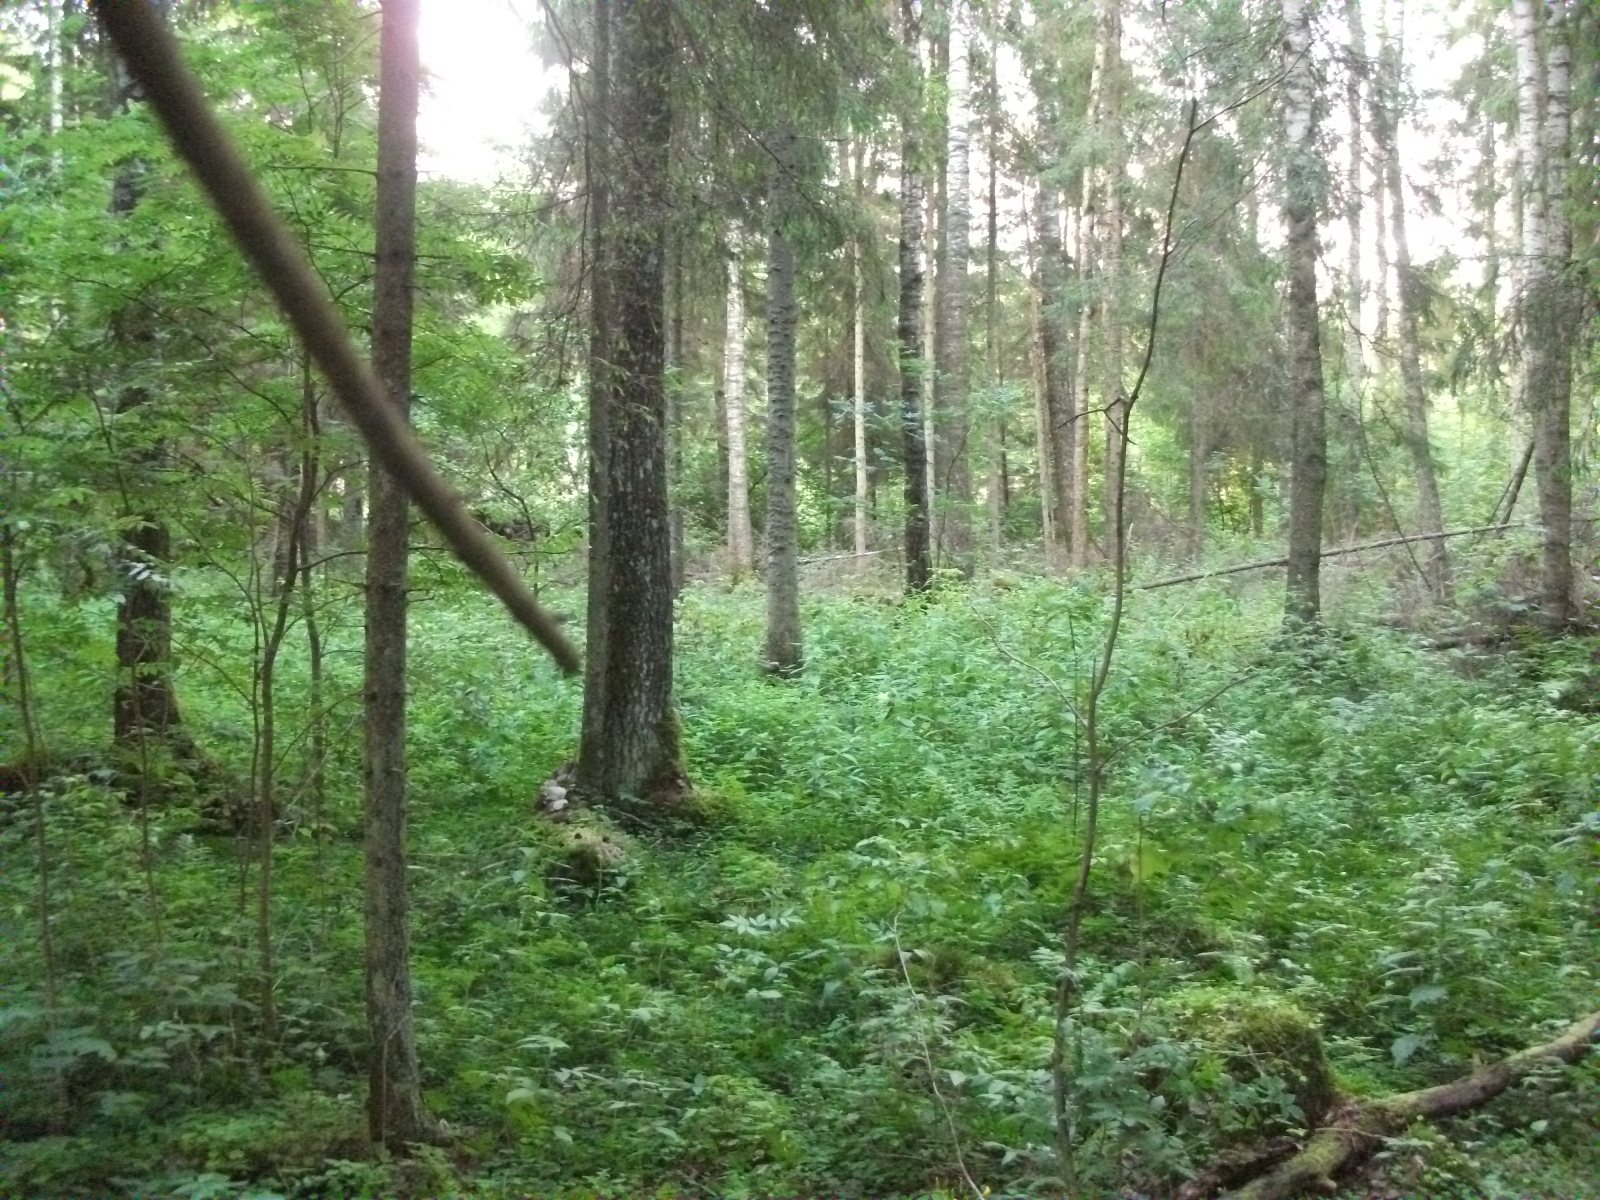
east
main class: Woodland
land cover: Spruce dominated mixed woodland
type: hemiboreal forest and nemoral coniferous forest and mixed broadleaved-coniferous forest
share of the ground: > 75 %
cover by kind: coniferous forest trees 60 %, broadleaved forest trees 25 %, shrubs 5 %, herbaceous plants 5 %, lichens and mosses 5 %
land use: Forestry
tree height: > 5 m
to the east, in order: Spruce dominated mixed woodland; Other structural elements; Ditches and canals; Abandoned hedges; Spontaneously vegetated surfaces; Spruce dominated mixed woodland; Broadleaved woodland
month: July
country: LV
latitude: 57.1382
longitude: 26.3163
